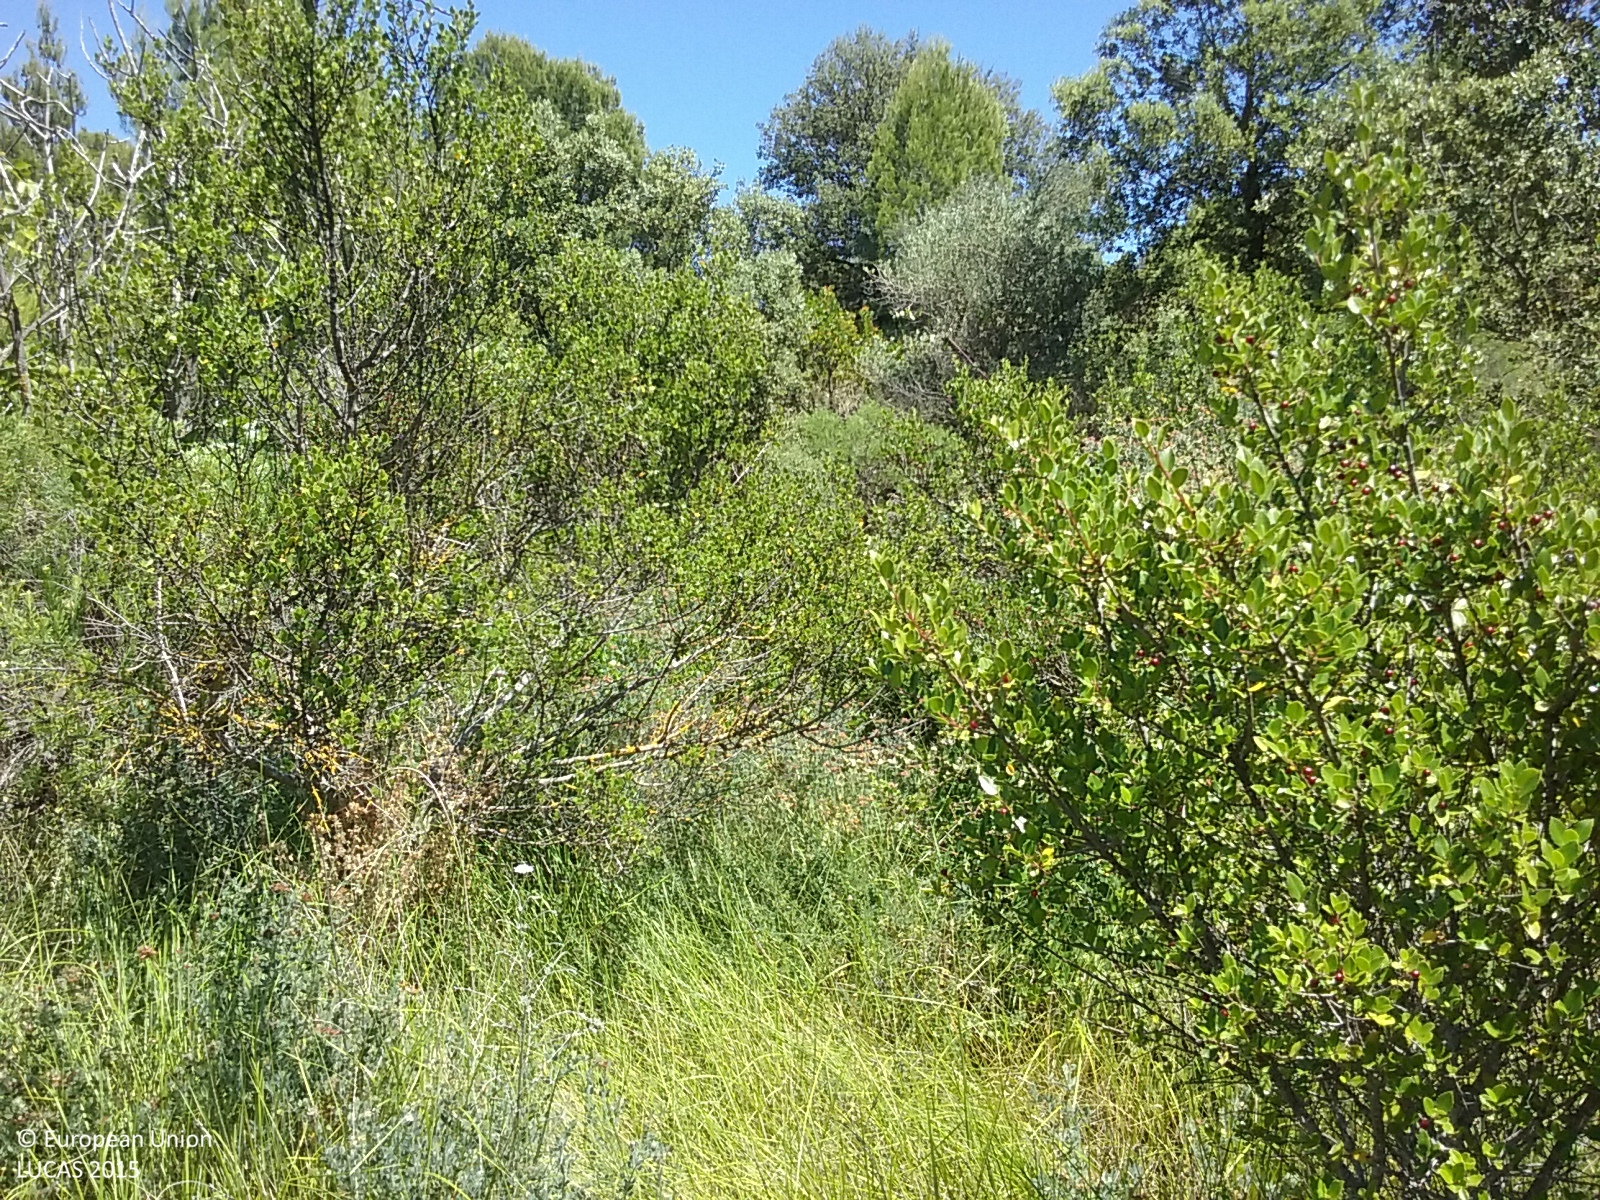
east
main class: Shrubland
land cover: Shrubland with sparse tree cover
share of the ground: 50 - 75 %
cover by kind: herbaceous plants 65 %, shrubs 30 %, broadleaved forest trees 5 %
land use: Semi-natural and natural areas not in use
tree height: < 5 m
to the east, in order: Shrubland with sparse tree cover; Dry stone walls; Olive groves; Dry stone walls; Olive groves; Dry stone walls; Pine dominated coniferous woodland; Shrubland without tree cover; Tracks; Pine dominated coniferous woodland; Shrubland without tree cover; Dry stone walls; Nuts trees; Dry stone walls; Shrubland with sparse tree cover; Dry stone walls; Shrubland with sparse tree cover; Dry stone walls; Nuts trees; Dry stone walls; Nuts trees; Dry stone walls; Shrubland with sparse tree cover
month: June
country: ES
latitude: 41.0459
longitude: 0.3428
